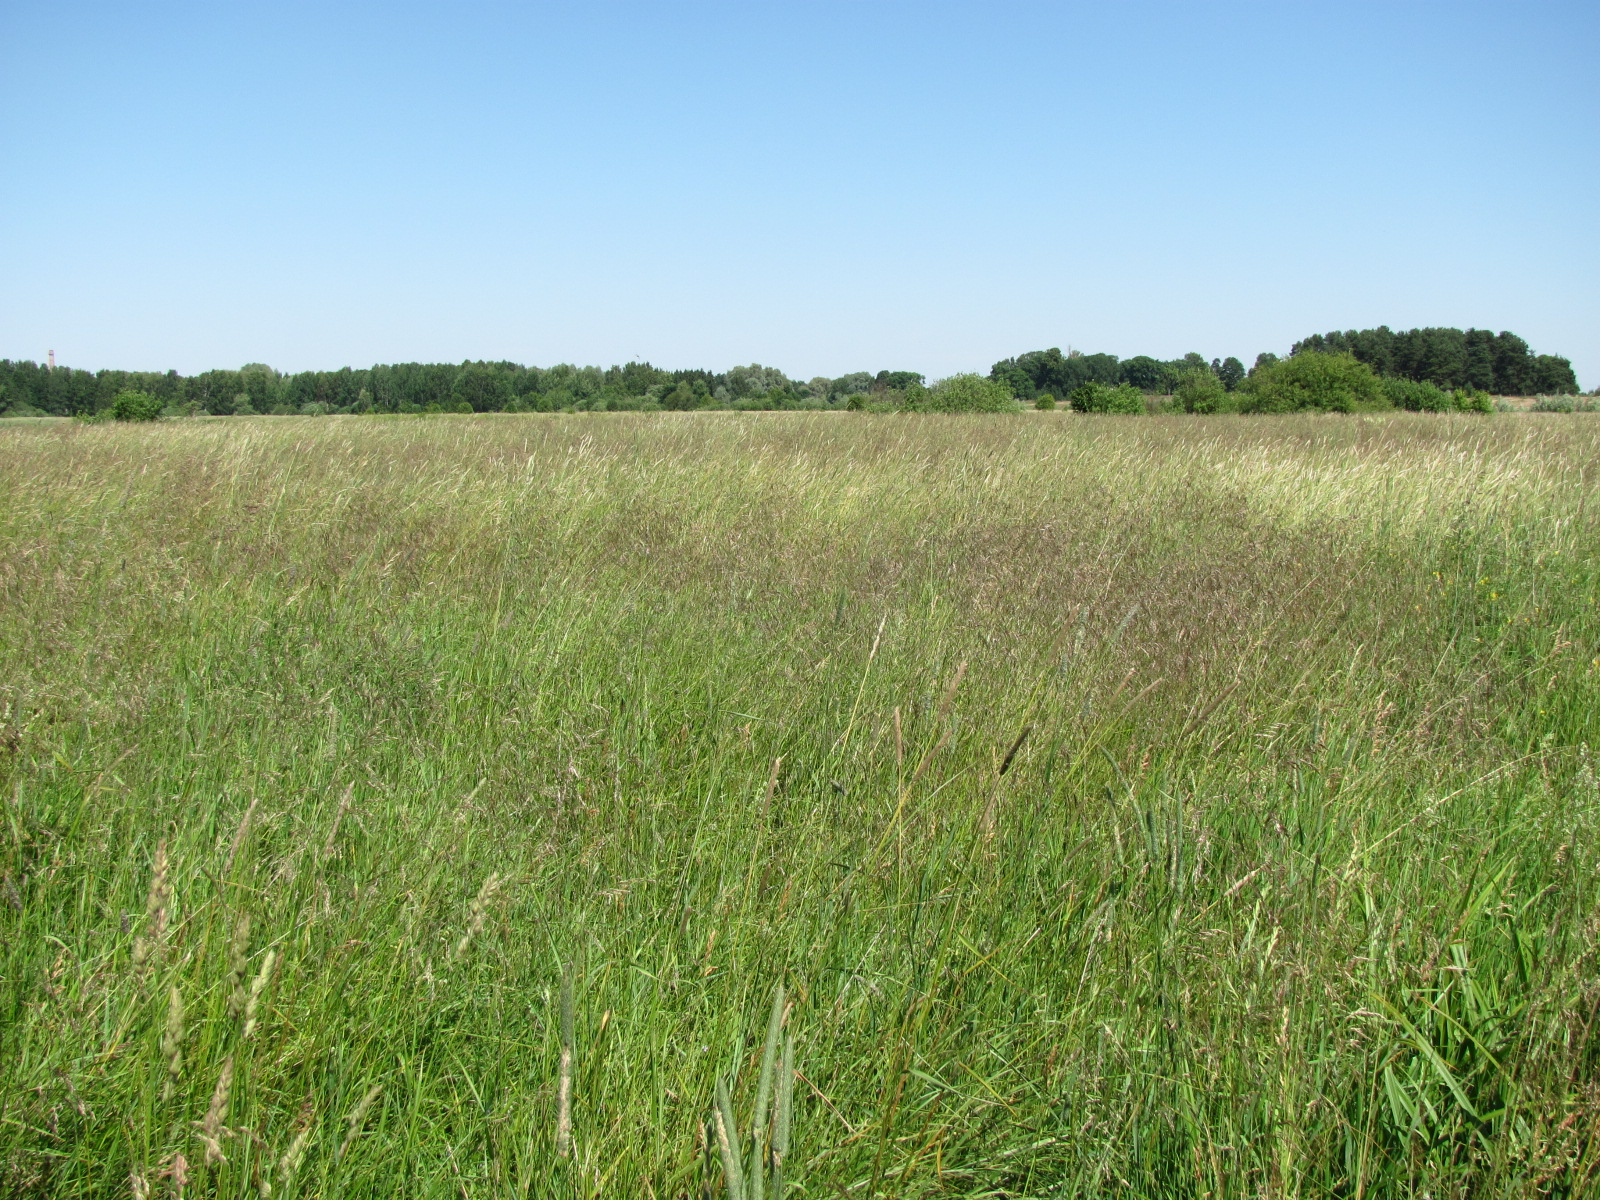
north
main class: Grassland
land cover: Grassland without tree/shrub cover
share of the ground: > 75 %
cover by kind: herbaceous plants 100 %
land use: Agriculture (excluding fallow land and kitchen gardens)
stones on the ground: < 10 %
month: July
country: LV
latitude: 56.8974
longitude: 24.1564
